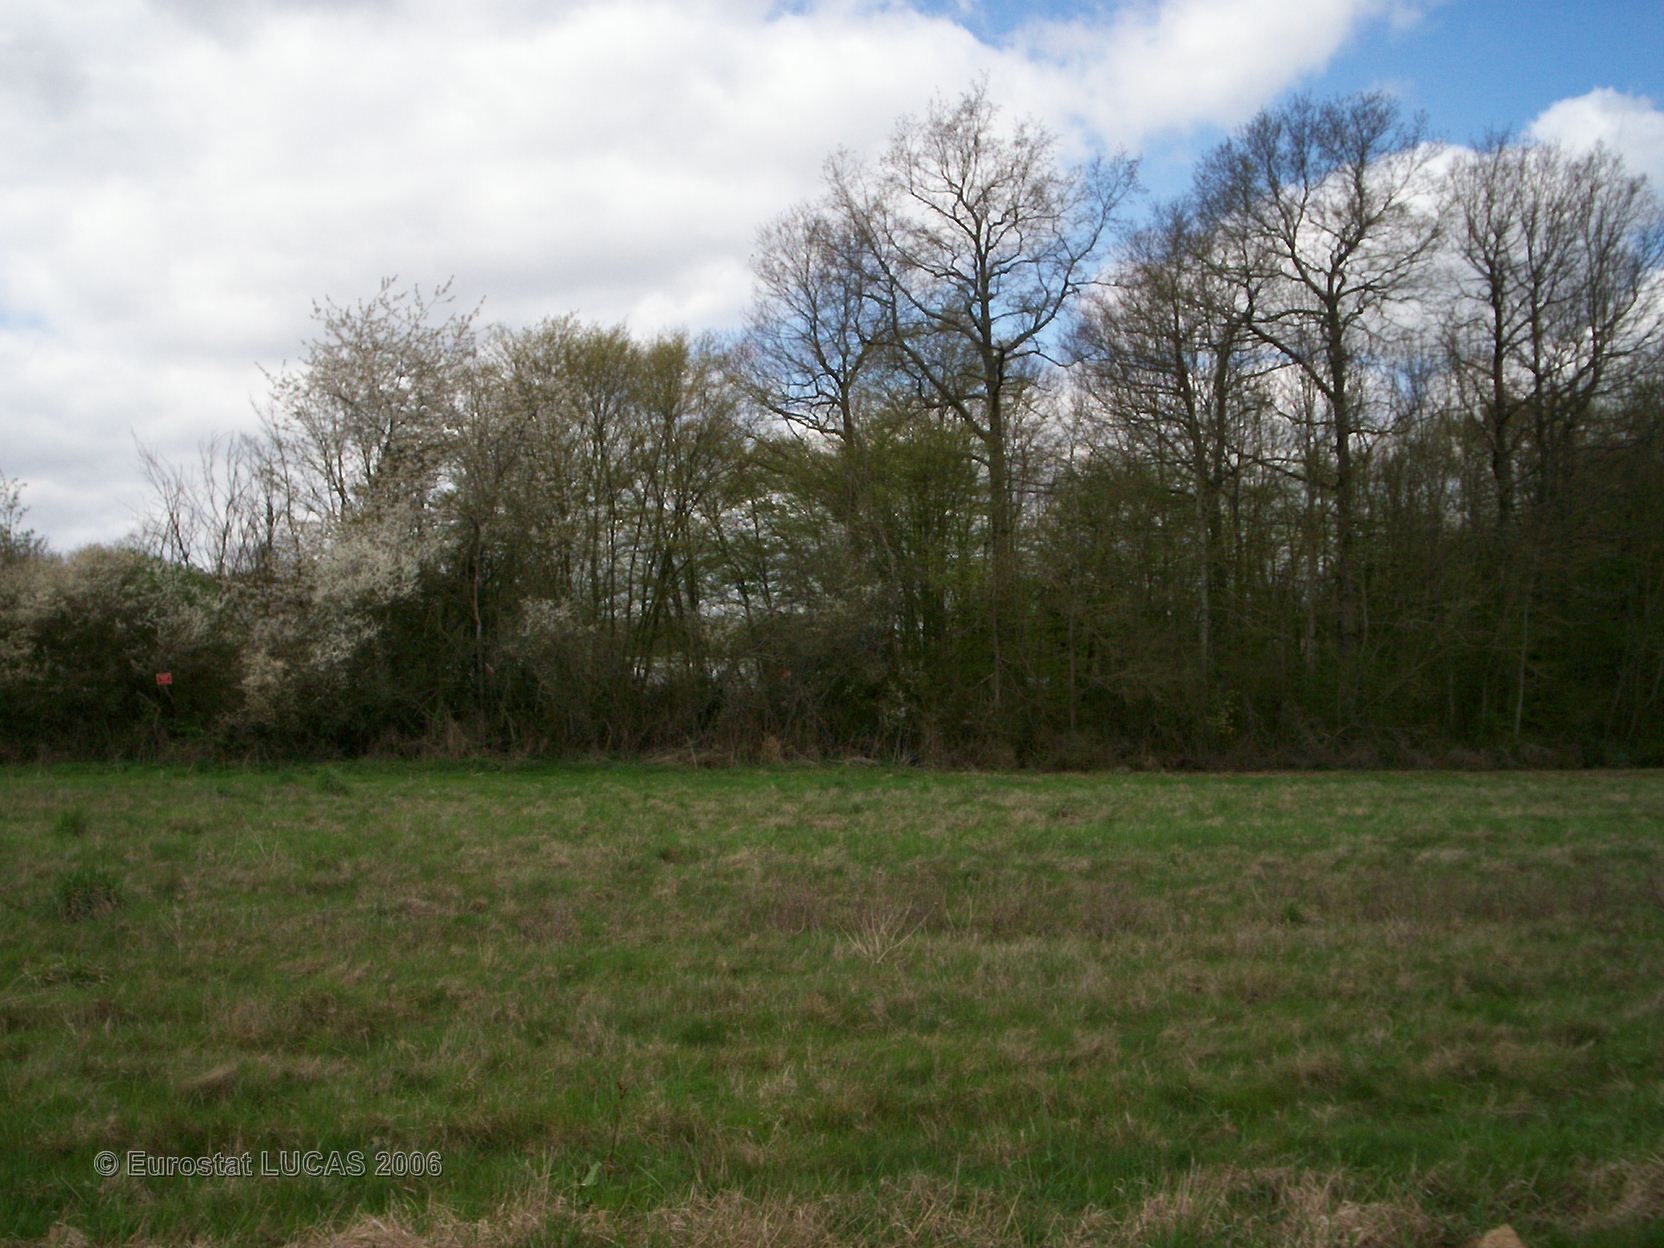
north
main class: Cropland
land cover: Maize
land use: Agriculture (excluding fallow land and kitchen gardens)
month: May
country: FR
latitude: 48.5530
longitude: 2.8786
